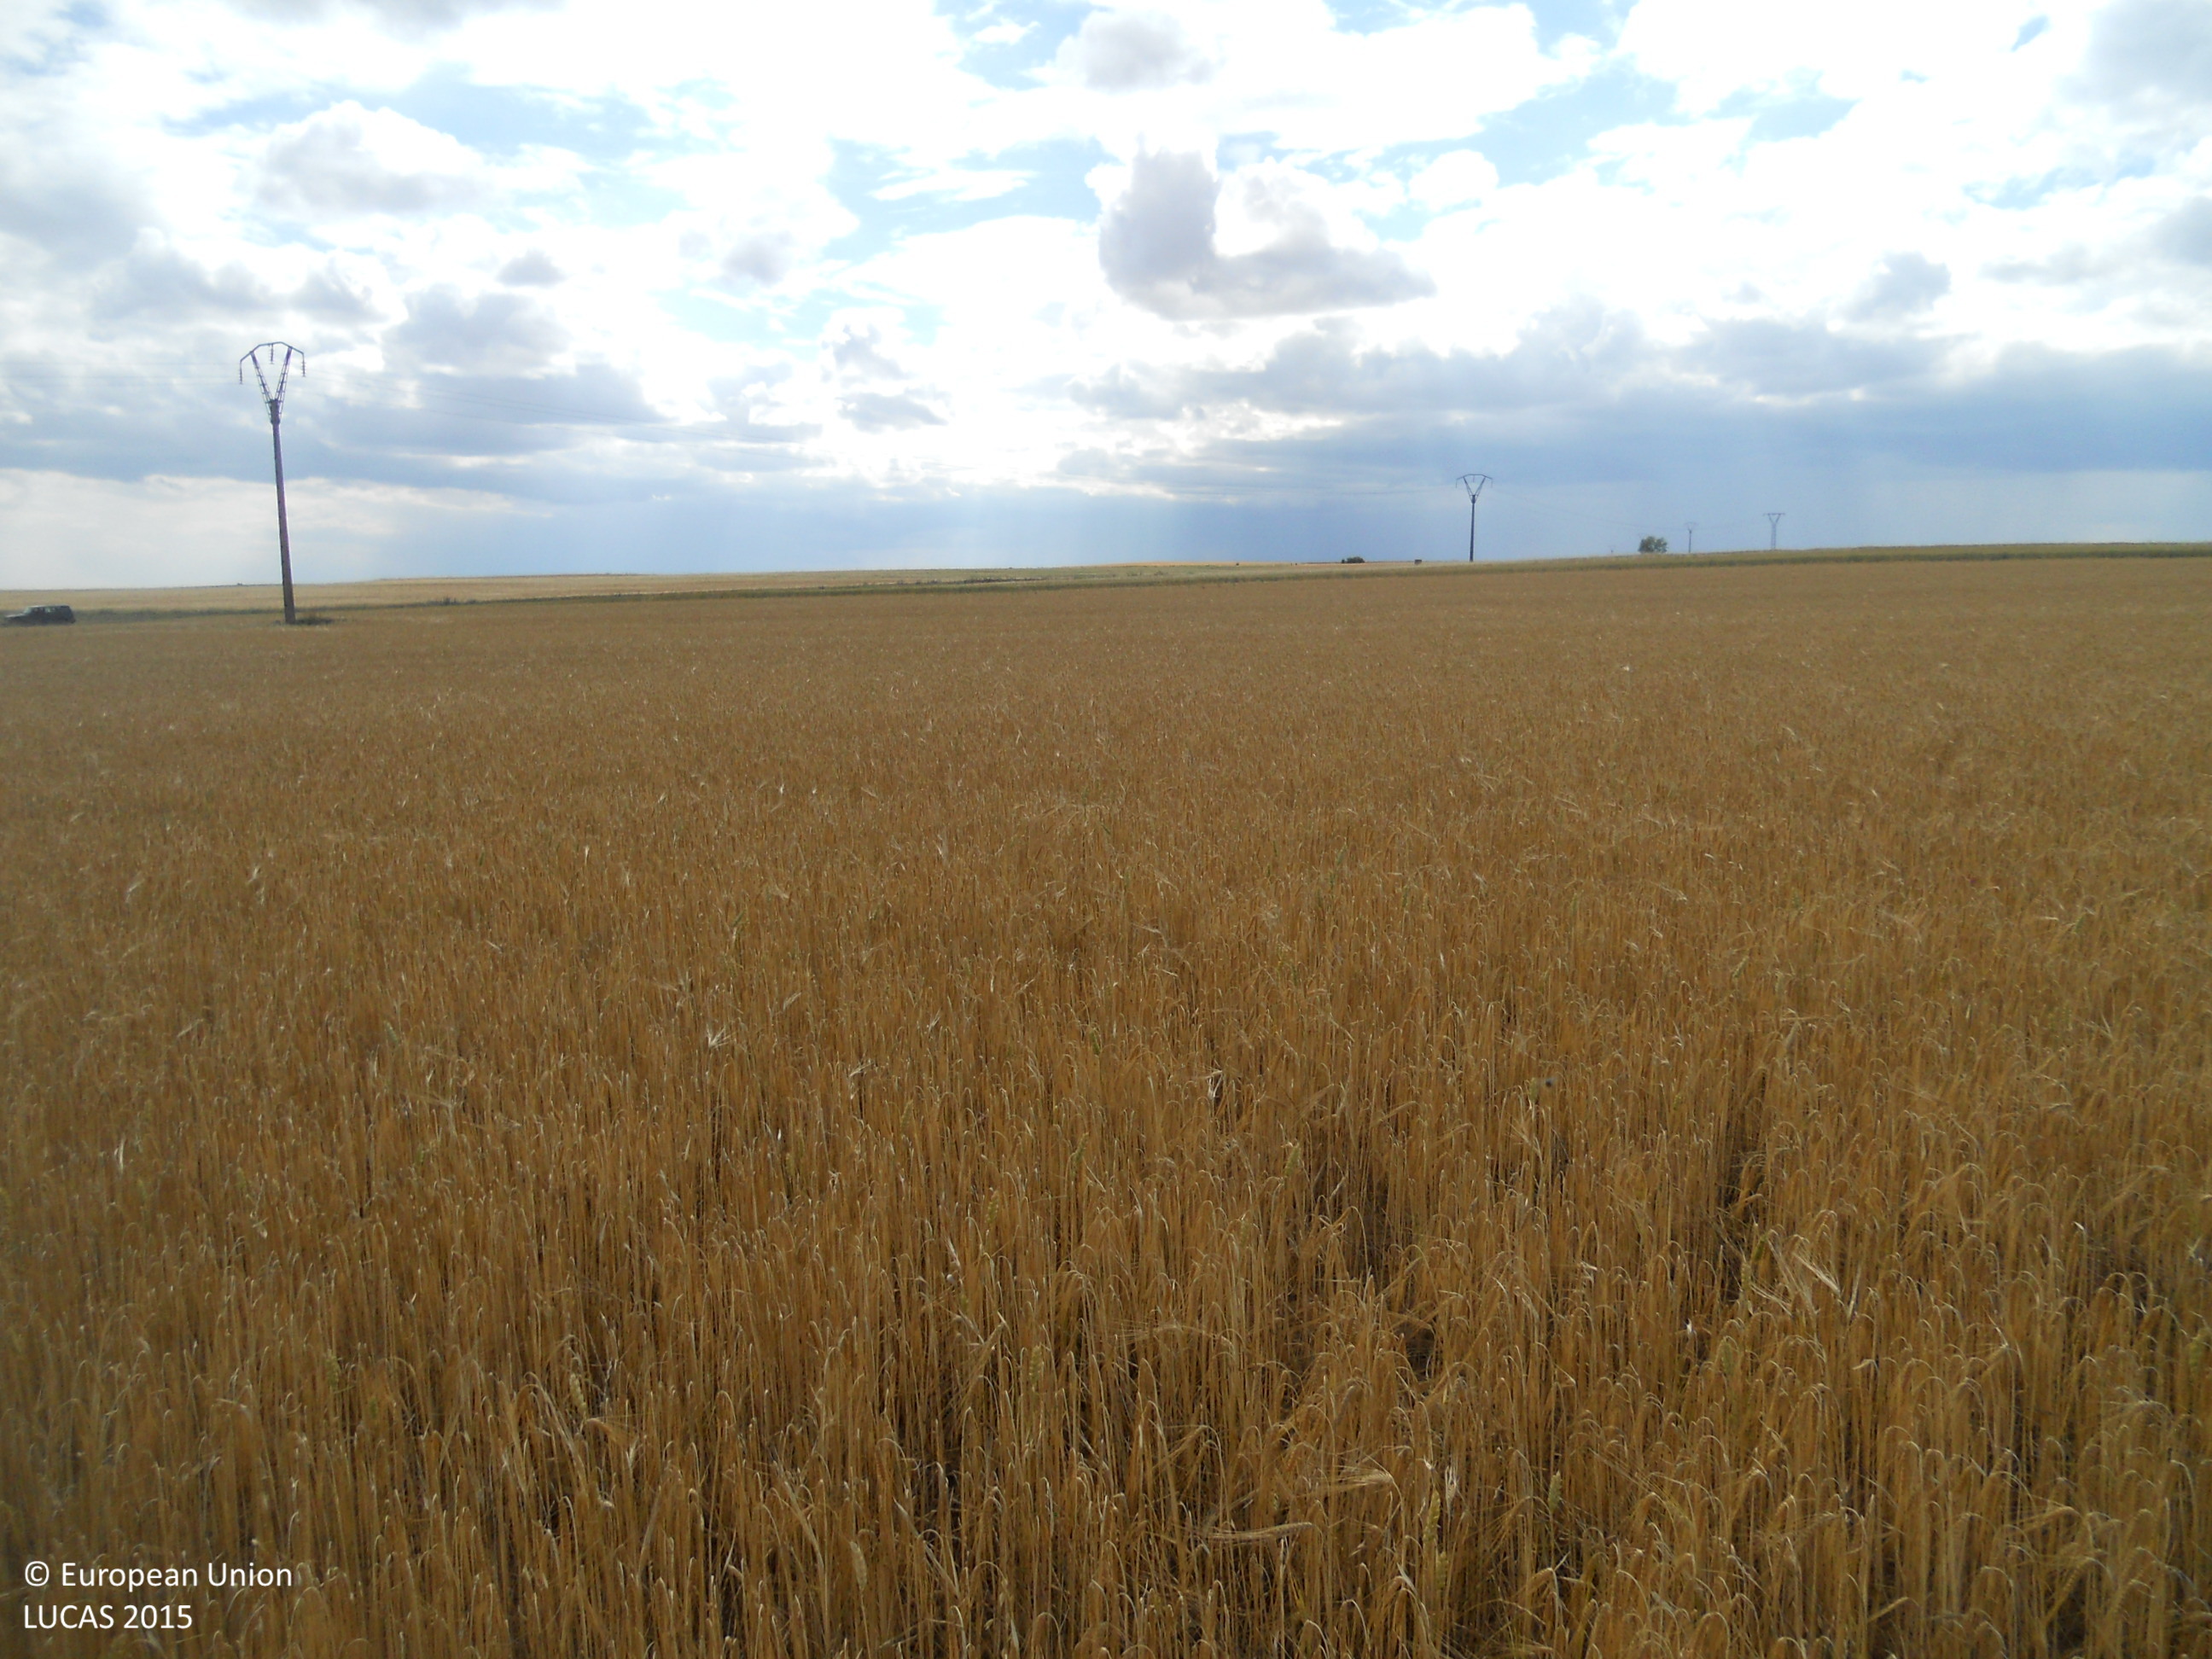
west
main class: Cropland
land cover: Barley
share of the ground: > 75 %
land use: Agriculture (excluding fallow land and kitchen gardens)
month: June
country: ES
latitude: 42.3545
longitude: -4.8797
